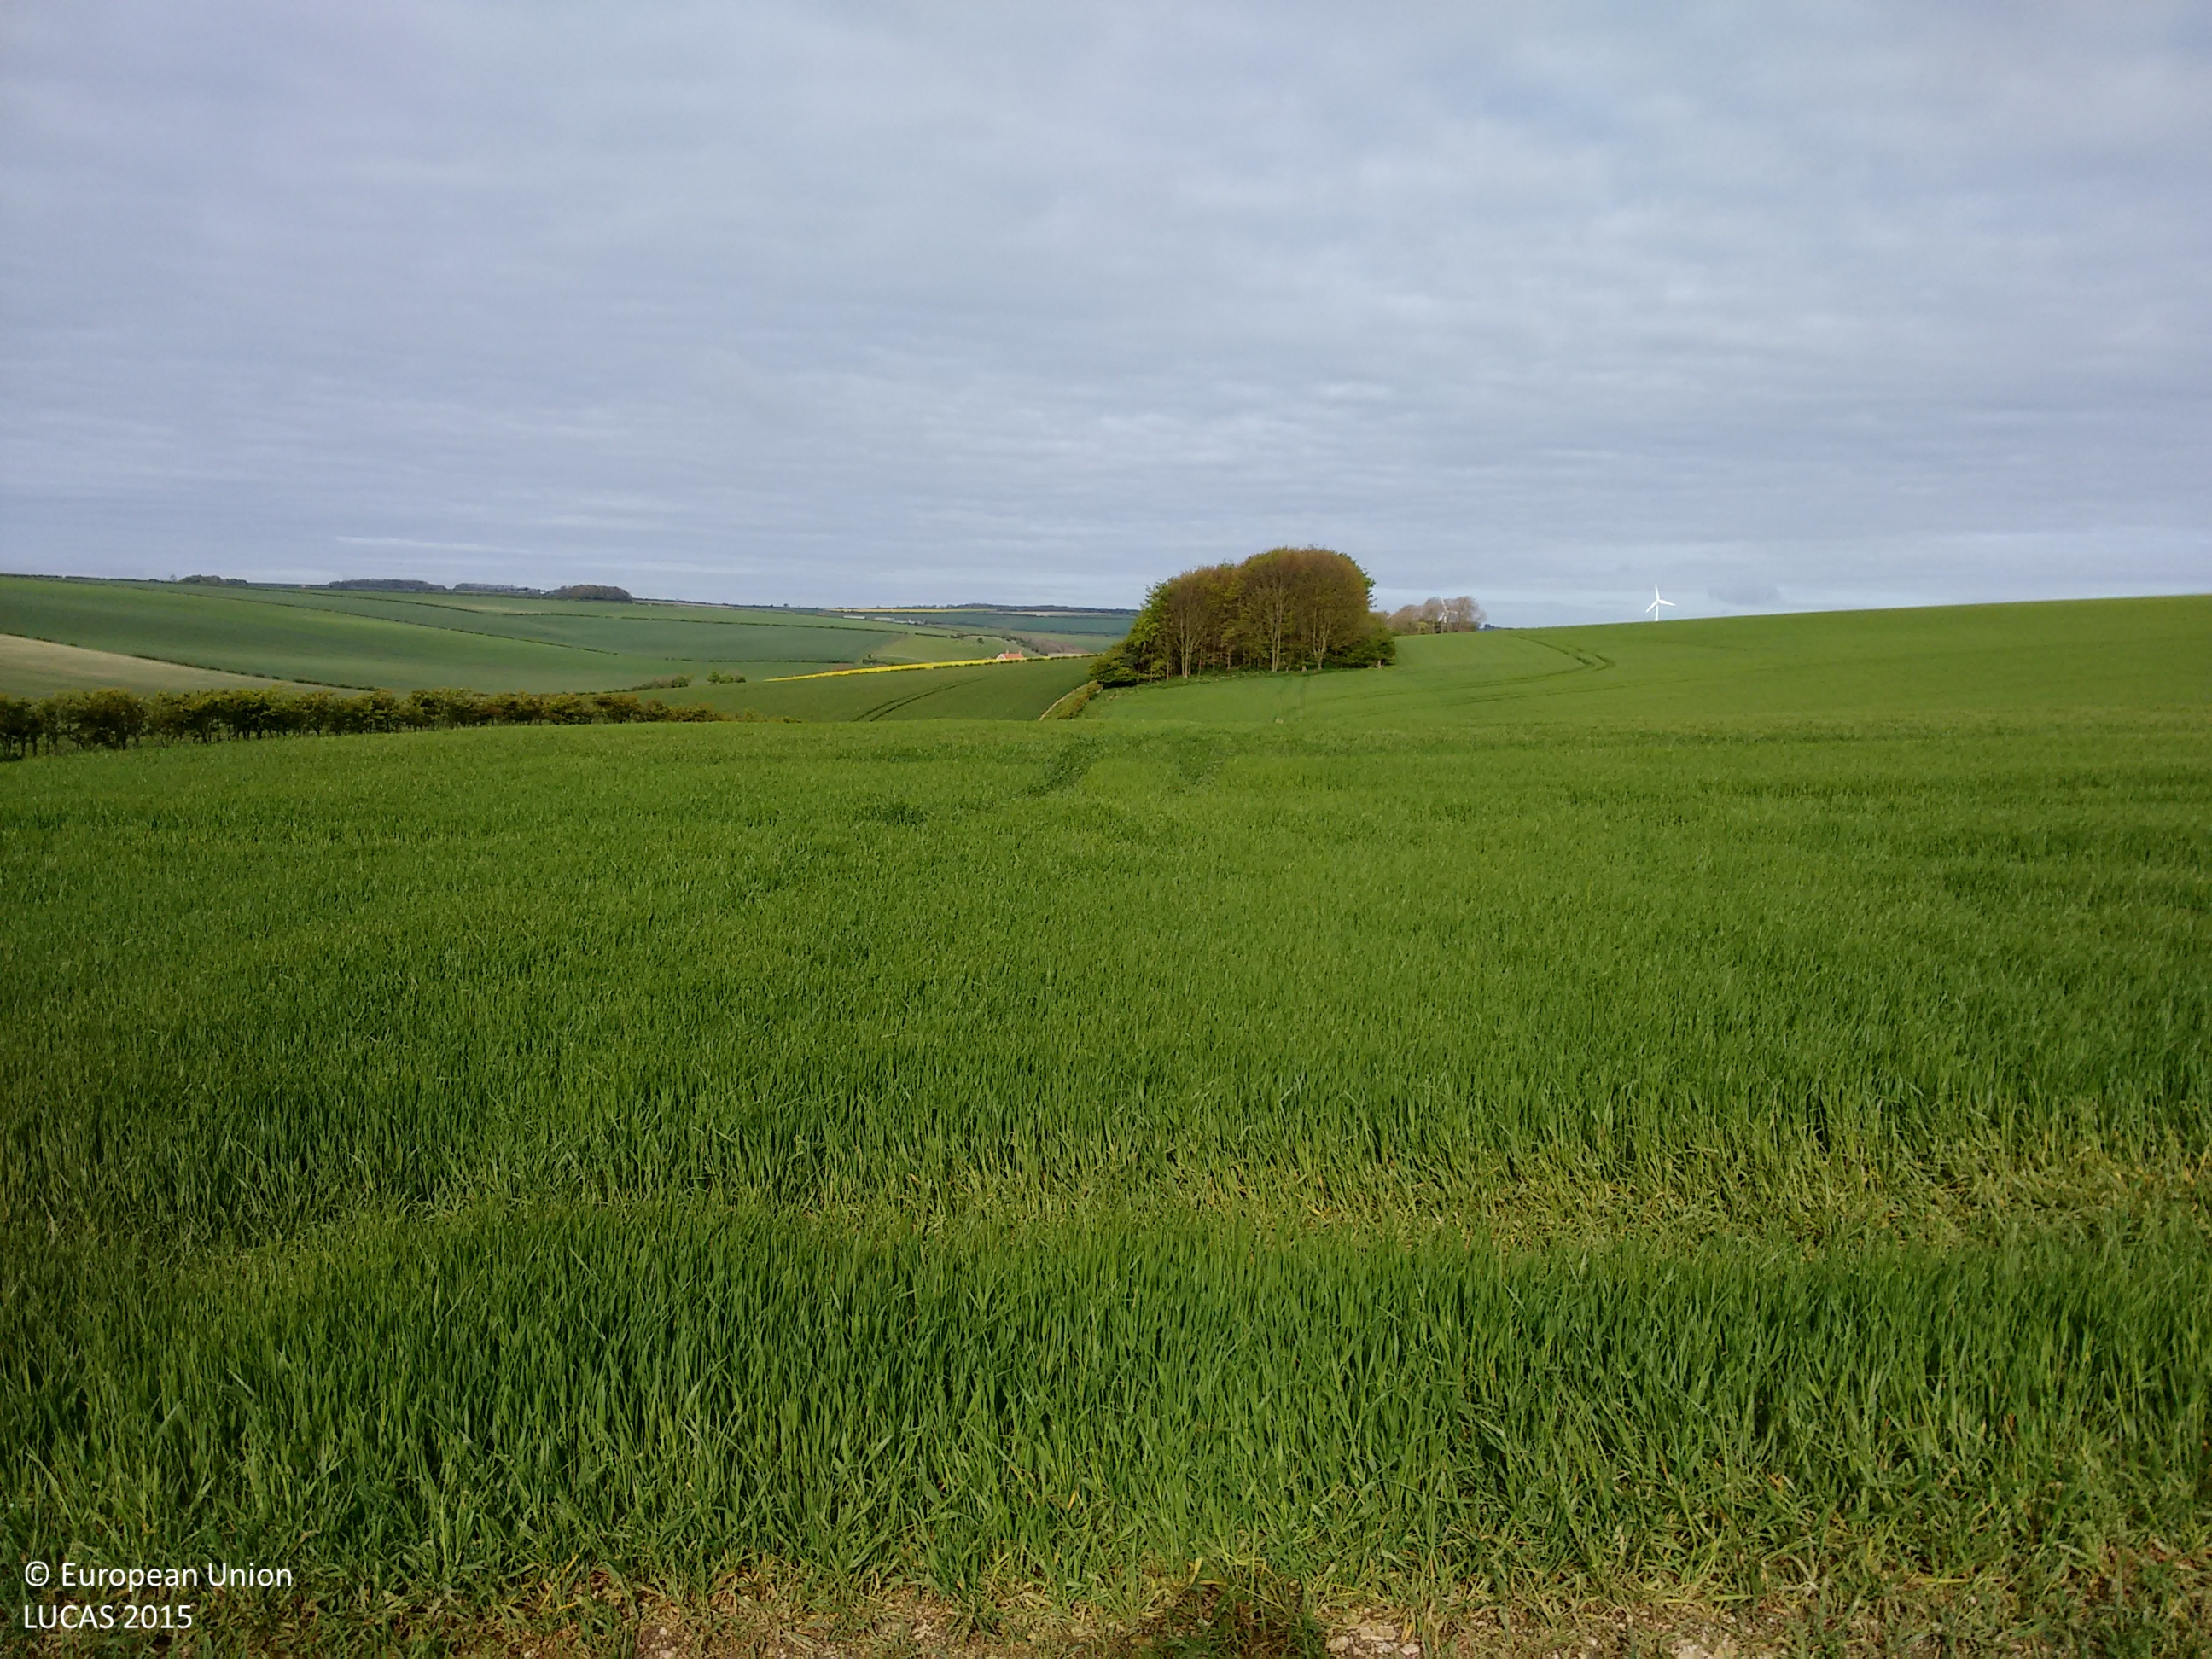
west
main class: Cropland
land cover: Barley
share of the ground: > 75 %
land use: Agriculture (excluding fallow land and kitchen gardens)
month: May
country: GB
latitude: 54.0761
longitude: -0.4129
